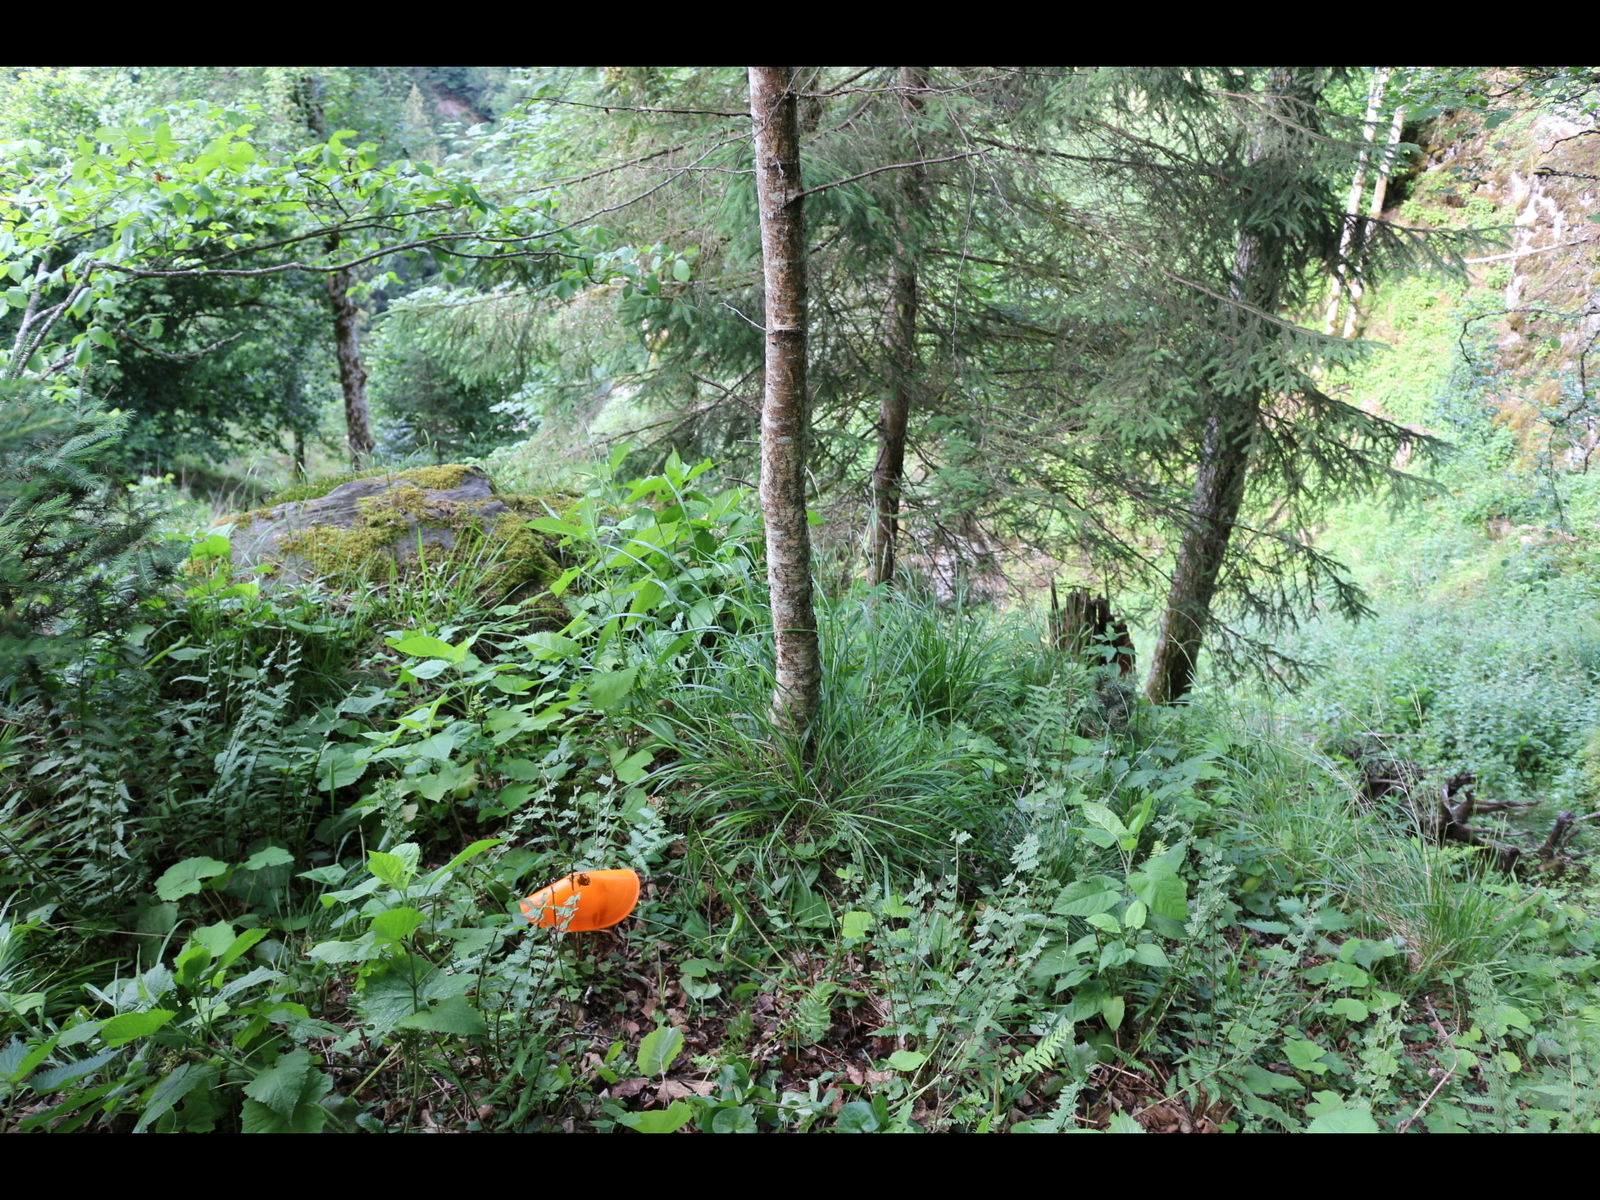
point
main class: Woodland
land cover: Broadleaved woodland
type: mountainous beech forest
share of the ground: > 75 %
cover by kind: broadleaved forest trees 90 %, coniferous forest trees 10 %
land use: Forestry
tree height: > 5 m
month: June
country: AT
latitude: 46.8404
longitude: 14.3380
